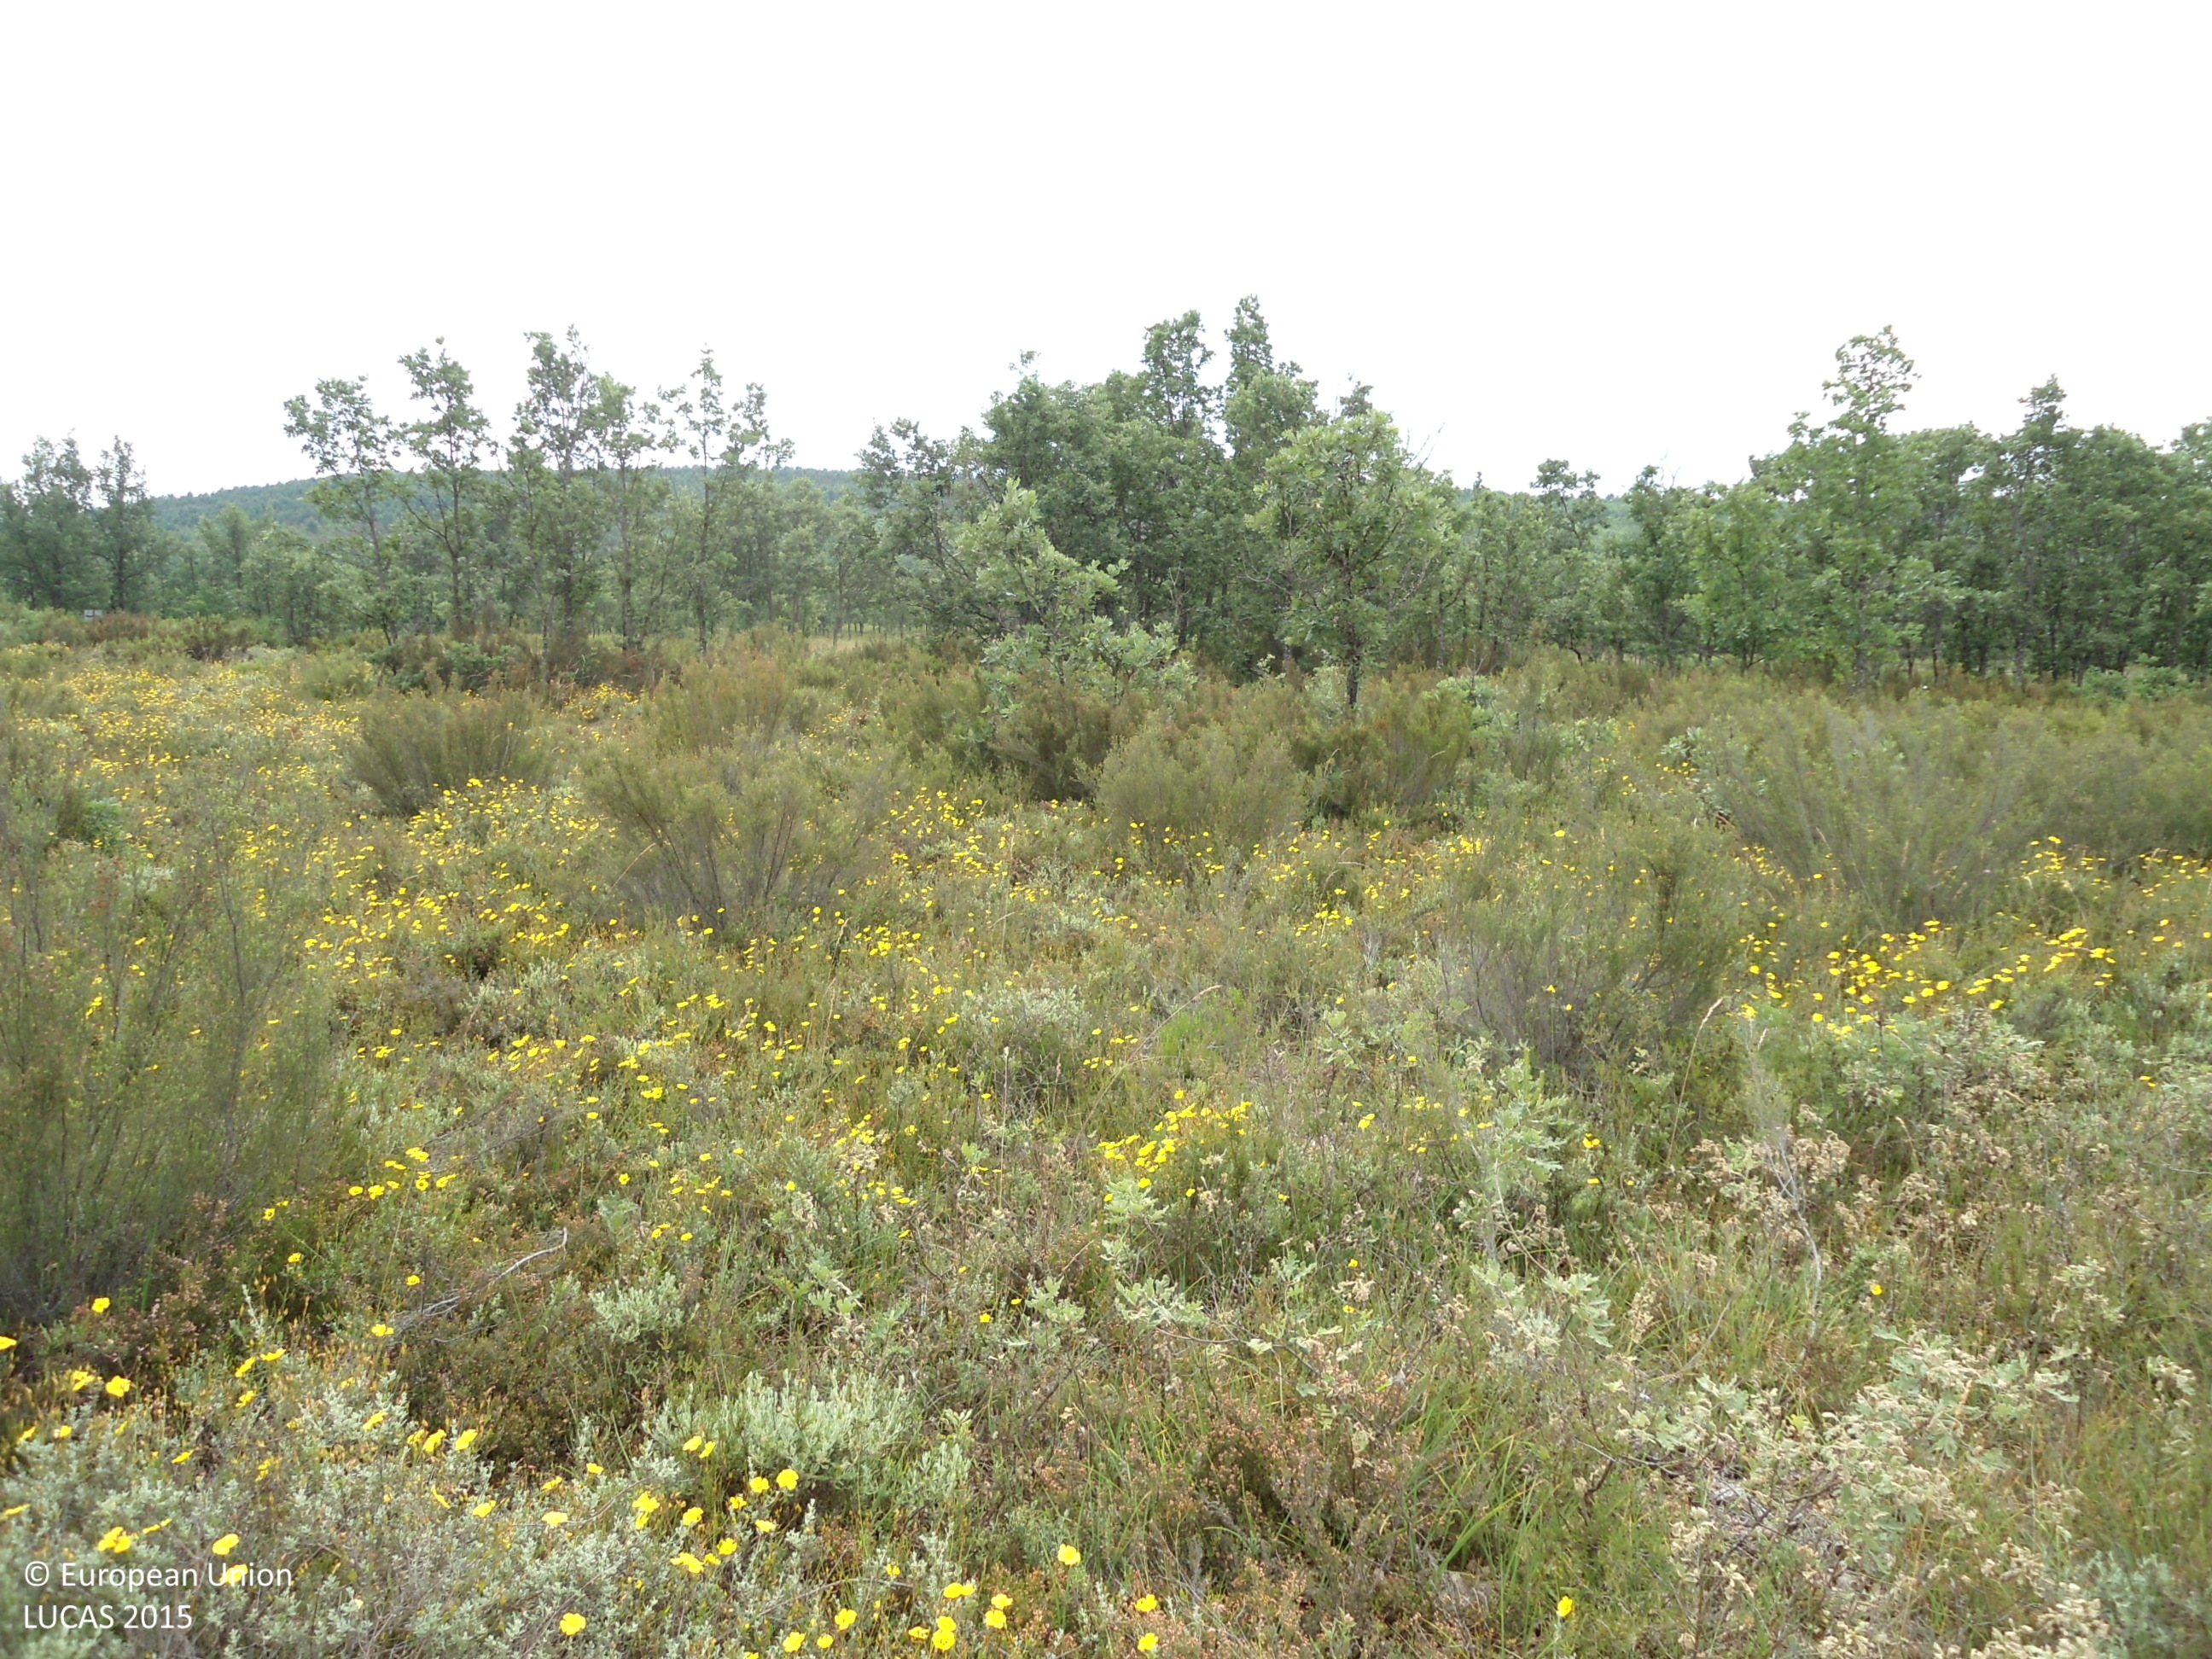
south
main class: Shrubland
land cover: Shrubland with sparse tree cover
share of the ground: > 75 %
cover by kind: shrubs 95 %, broadleaved forest trees 5 %
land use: Semi-natural and natural areas not in use
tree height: < 5 m
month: June
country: ES
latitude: 41.9475
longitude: -6.3051
